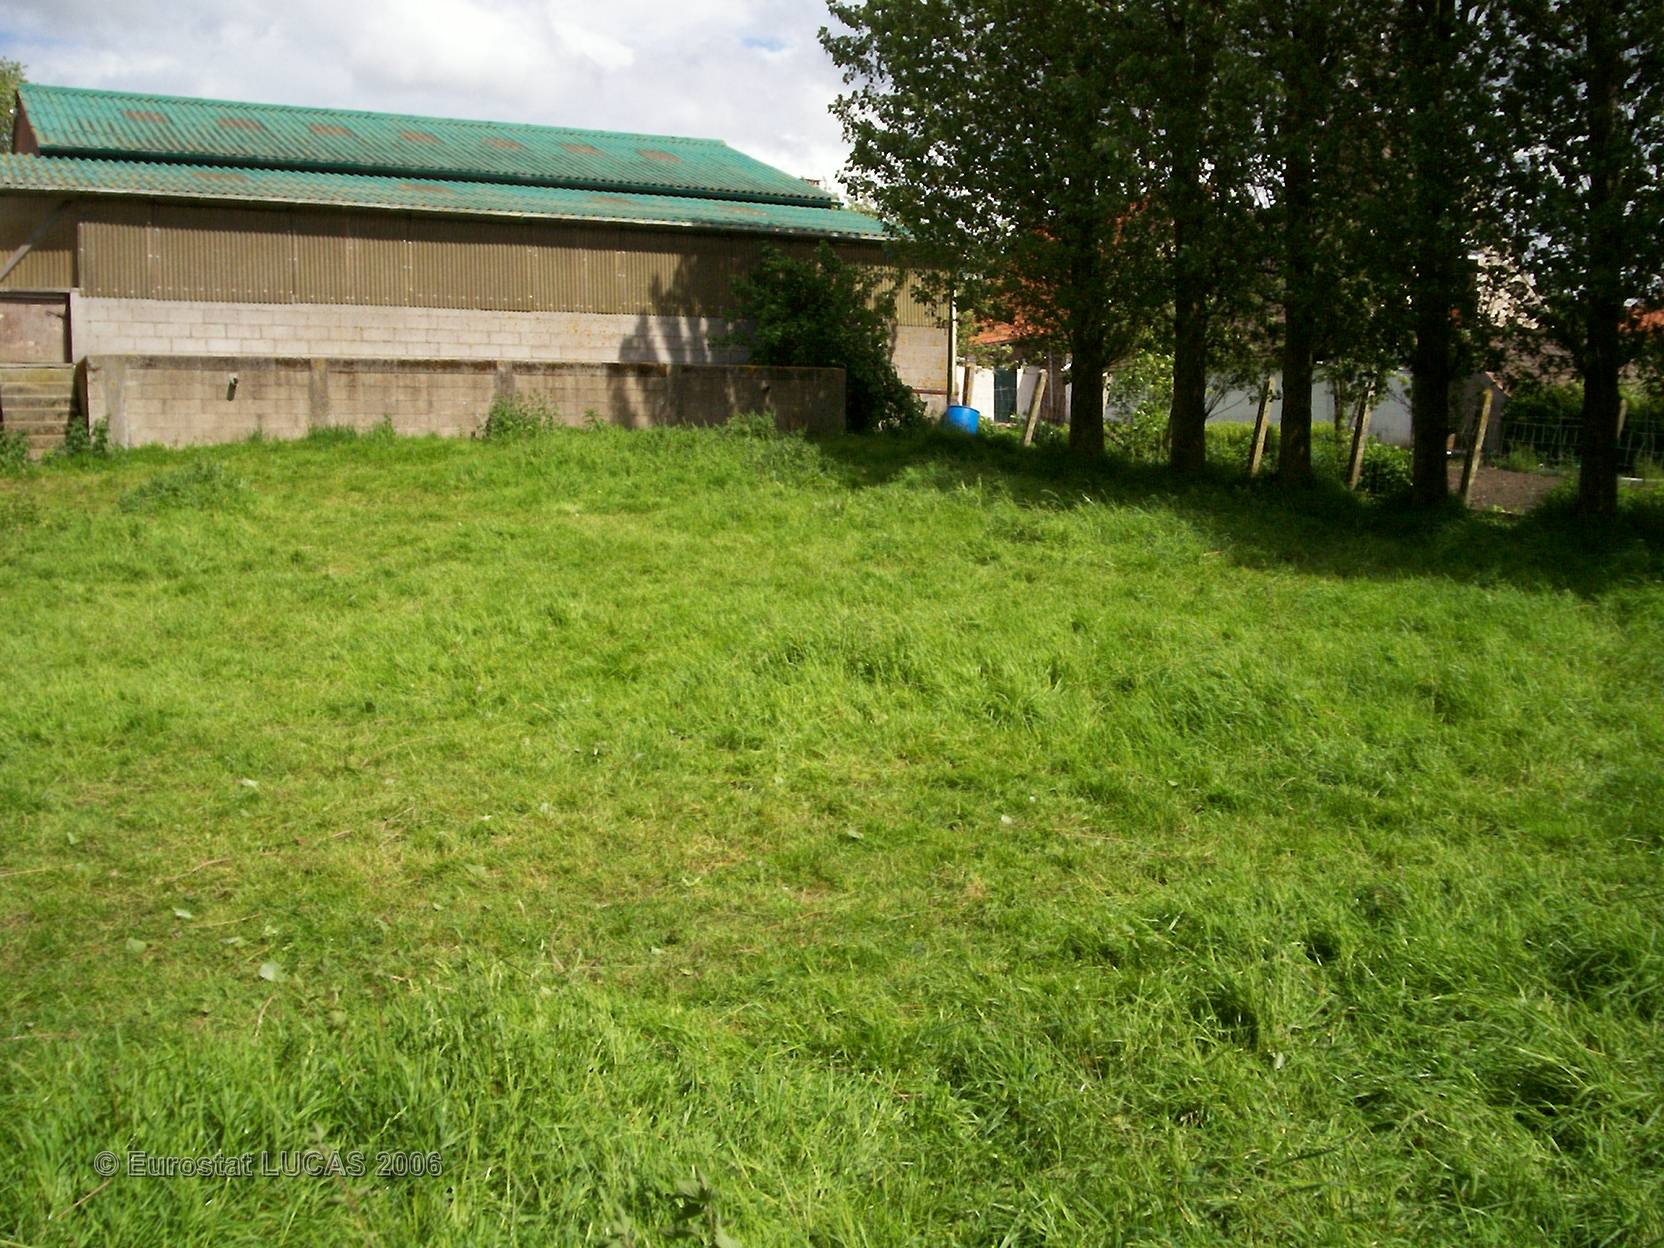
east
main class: Grassland
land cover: Grassland with sparse tree/shrub cover
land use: Agriculture (excluding fallow land and kitchen gardens)
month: May
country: FR
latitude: 50.9117
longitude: 2.4918
